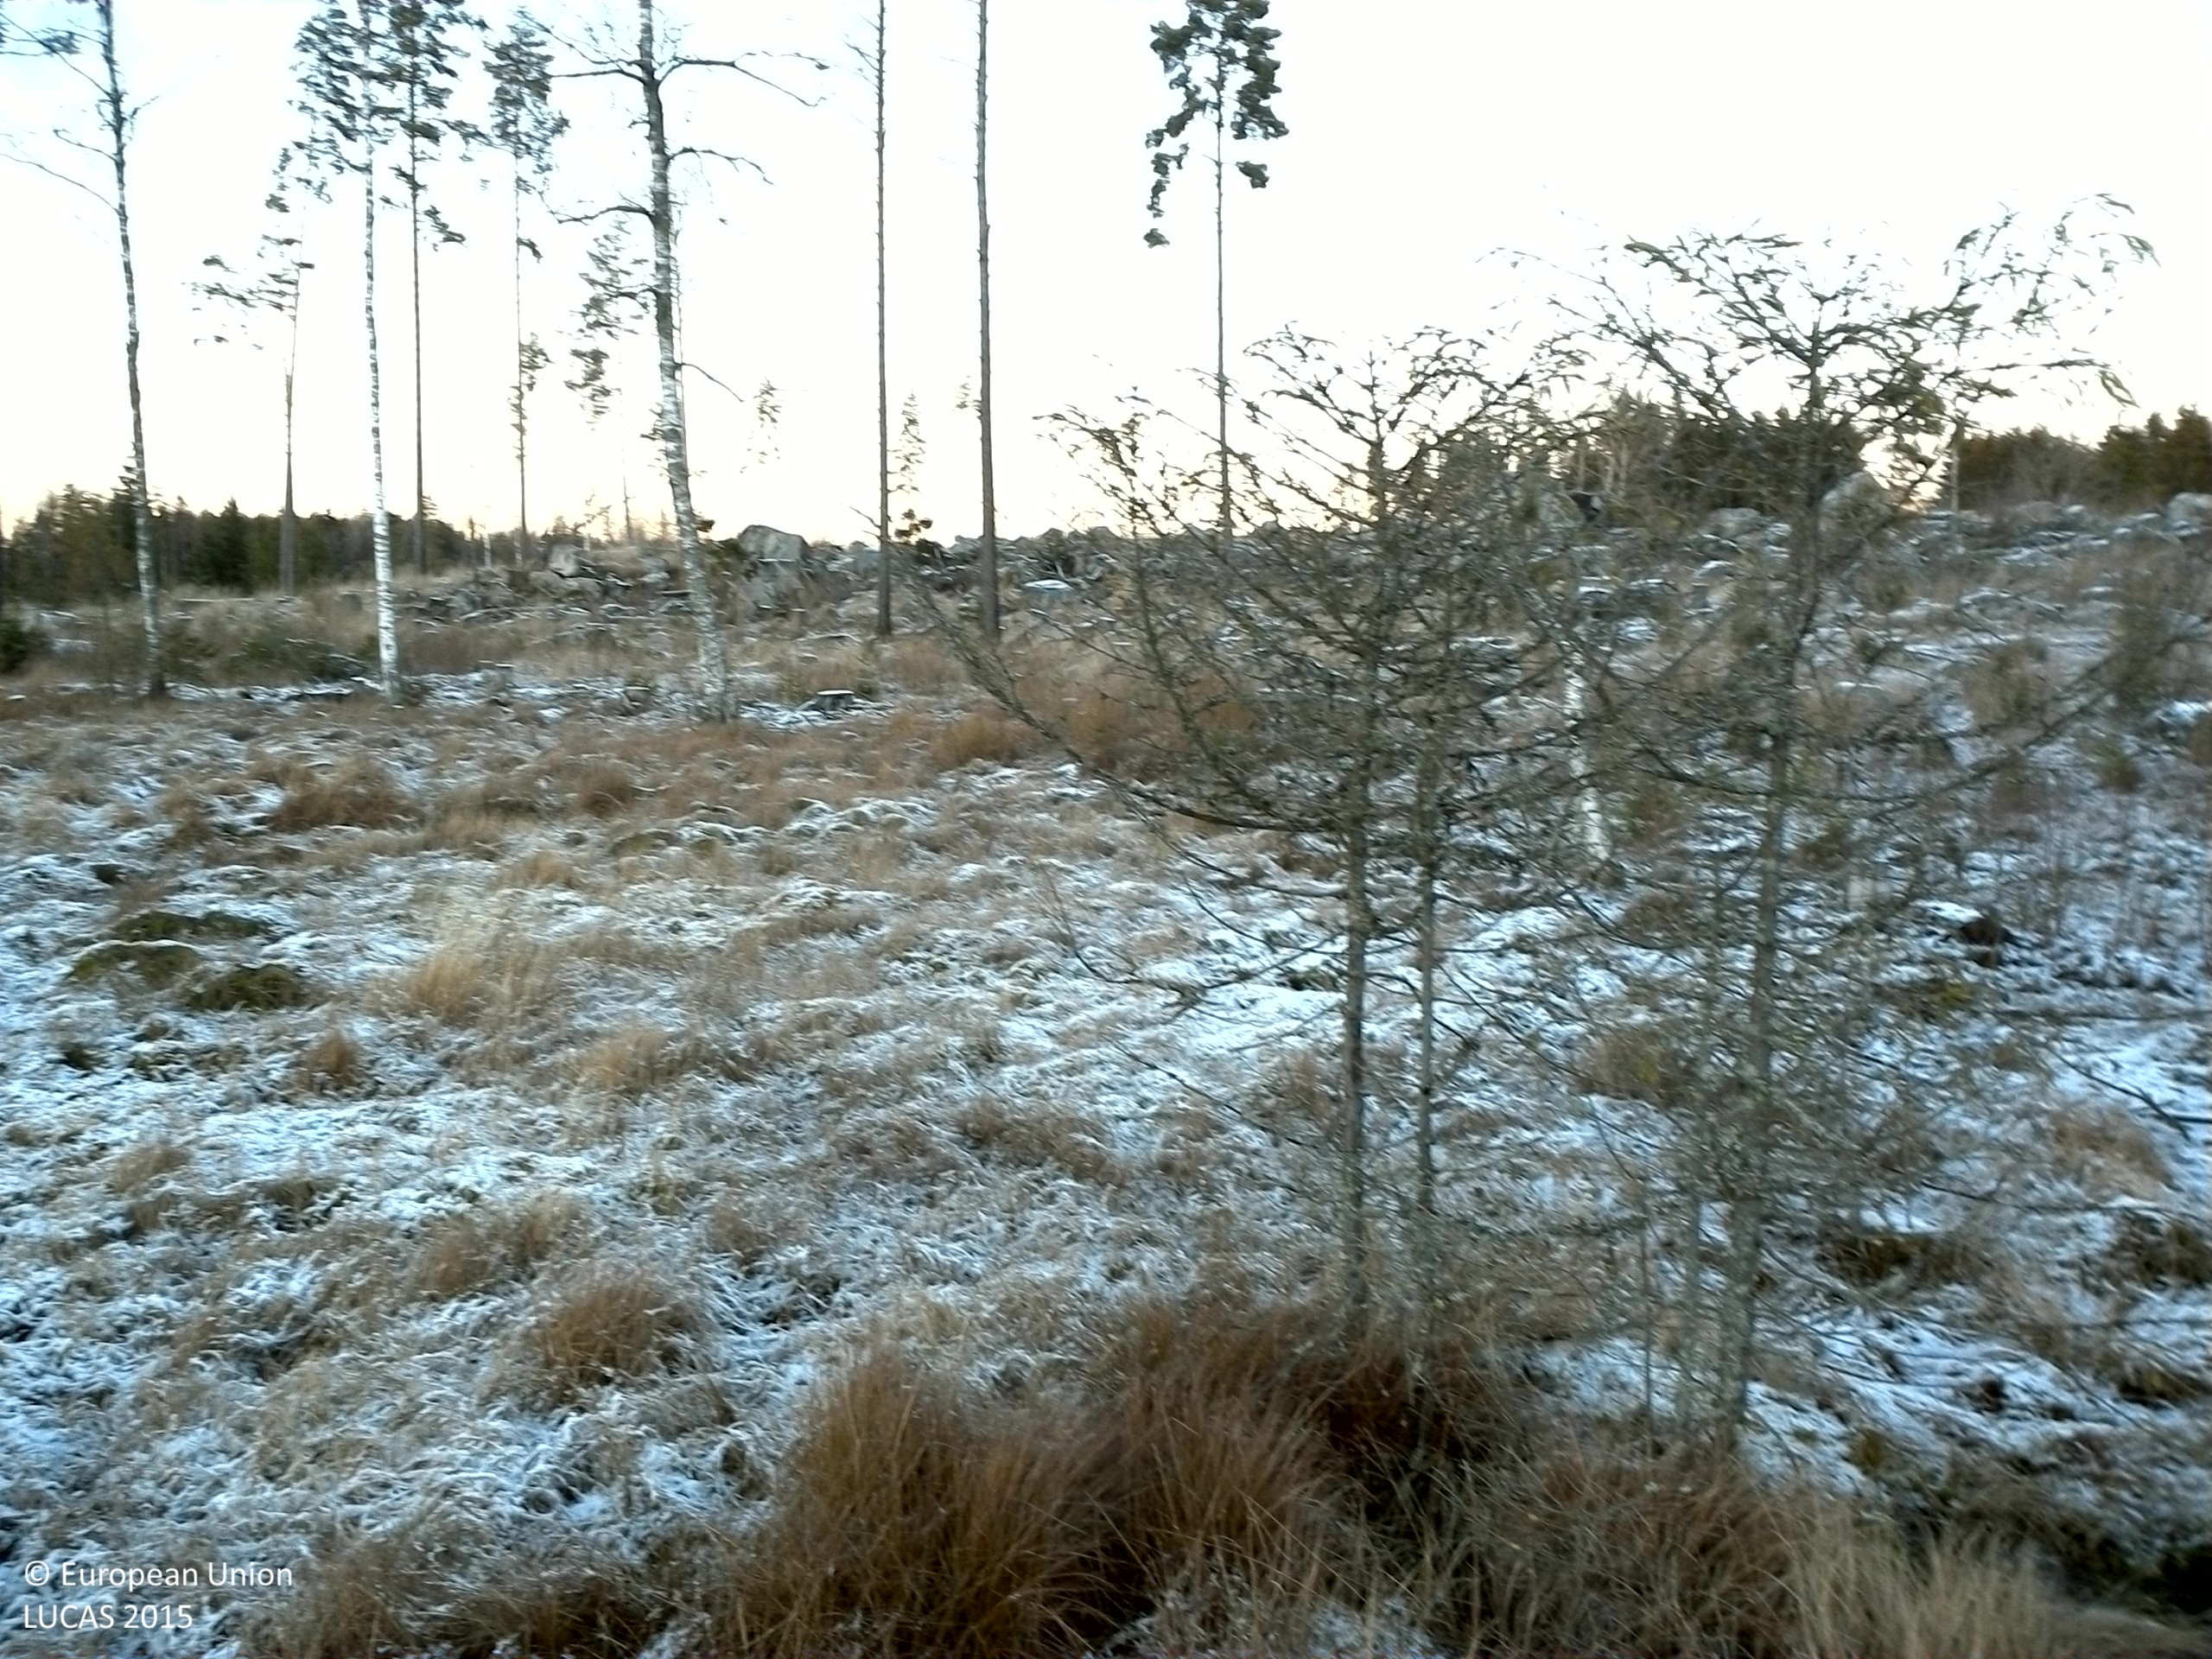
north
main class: Grassland
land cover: Grassland with sparse tree/shrub cover
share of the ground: 50 - 75 %
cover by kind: herbaceous plants 55 %, lichens and mosses 20 %, shrubs 10 %, consolidated bare surface 10 %, broadleaved forest trees 5 %
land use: Forestry
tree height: > 5 m
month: November
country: SE
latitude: 59.7652
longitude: 16.3830
